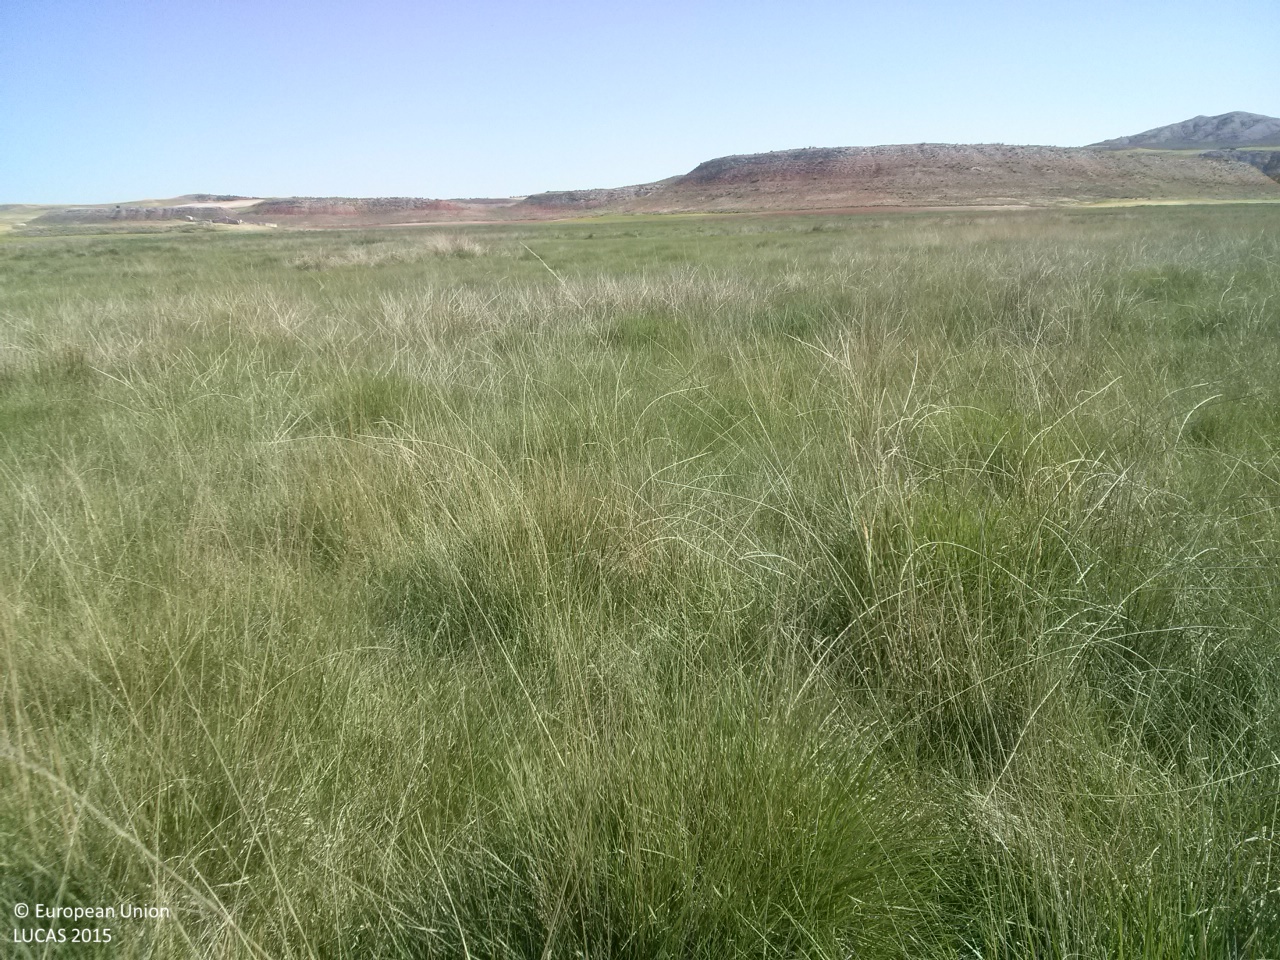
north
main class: Grassland
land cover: Grassland without tree/shrub cover
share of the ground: > 75 %
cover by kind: herbaceous plants 100 %
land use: Semi-natural and natural areas not in use
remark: Temporary flooded
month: May
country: ES
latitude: 40.1827
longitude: -2.7425
